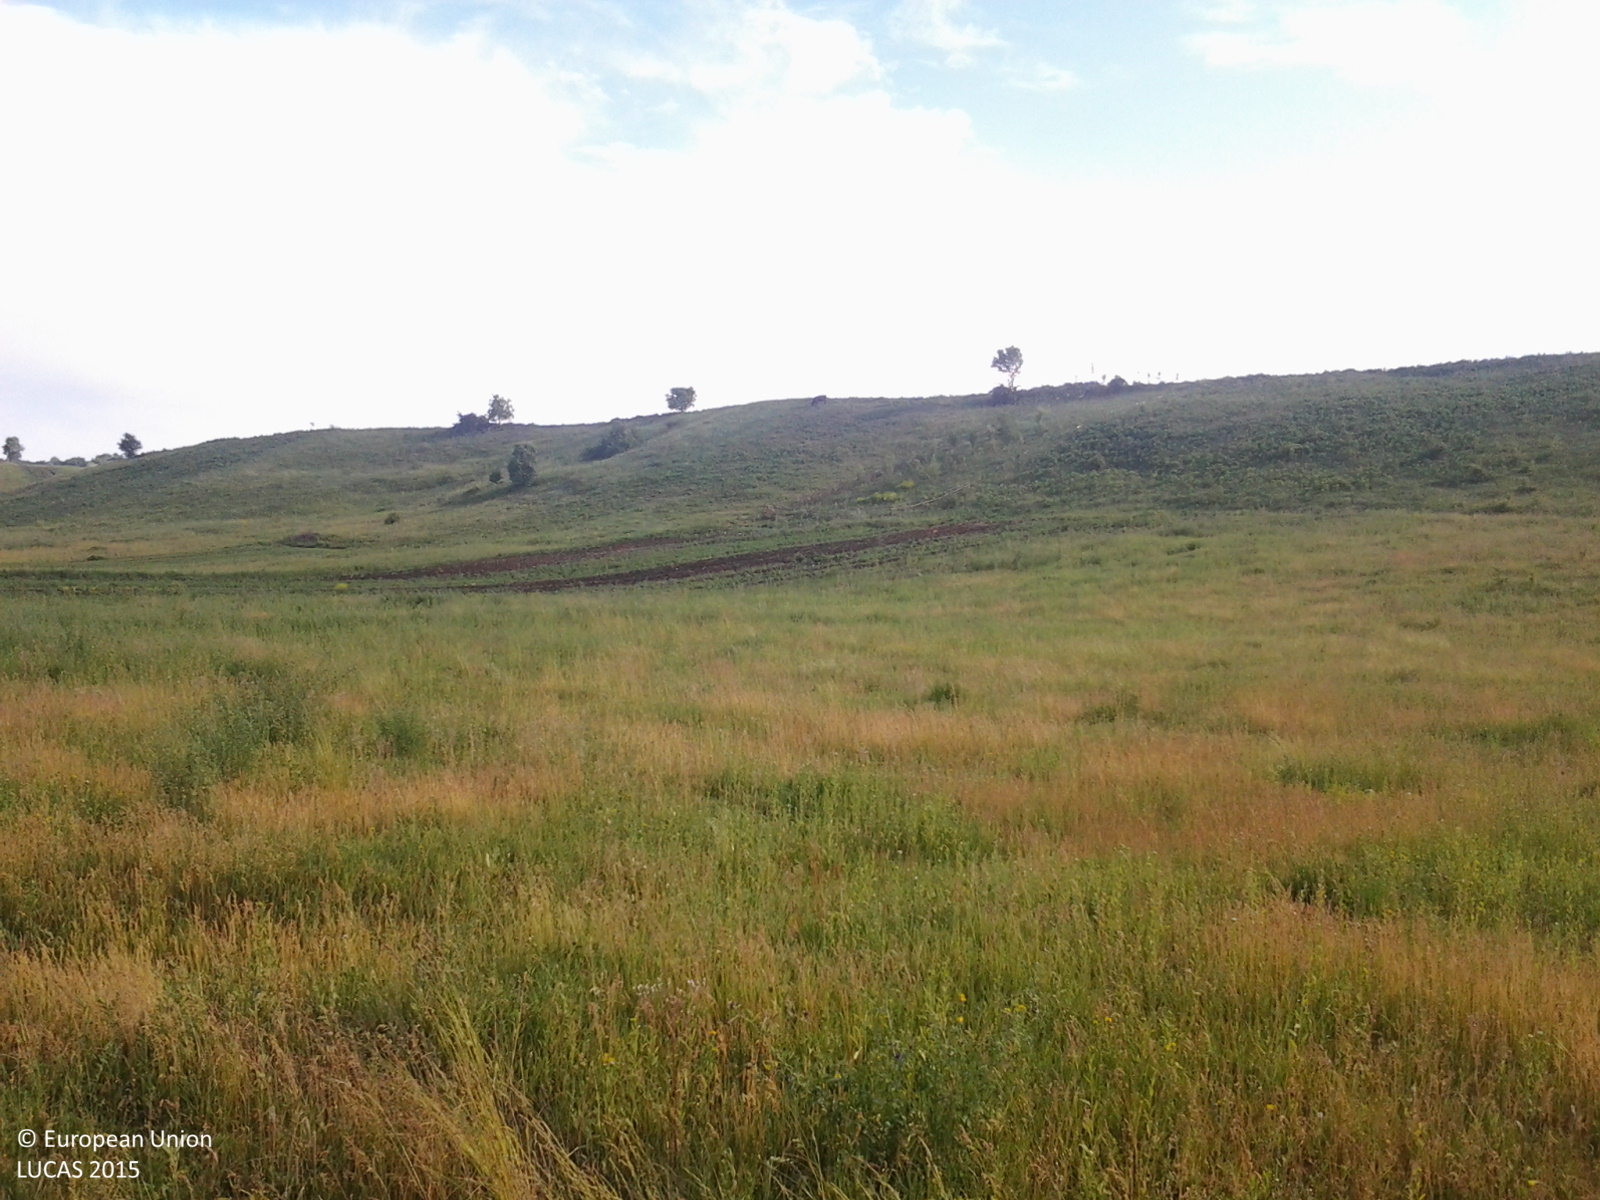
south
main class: Cropland
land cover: Lucerne
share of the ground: > 75 %
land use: Agriculture (excluding fallow land and kitchen gardens)
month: June
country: RO
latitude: 46.7346
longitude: 26.5883
